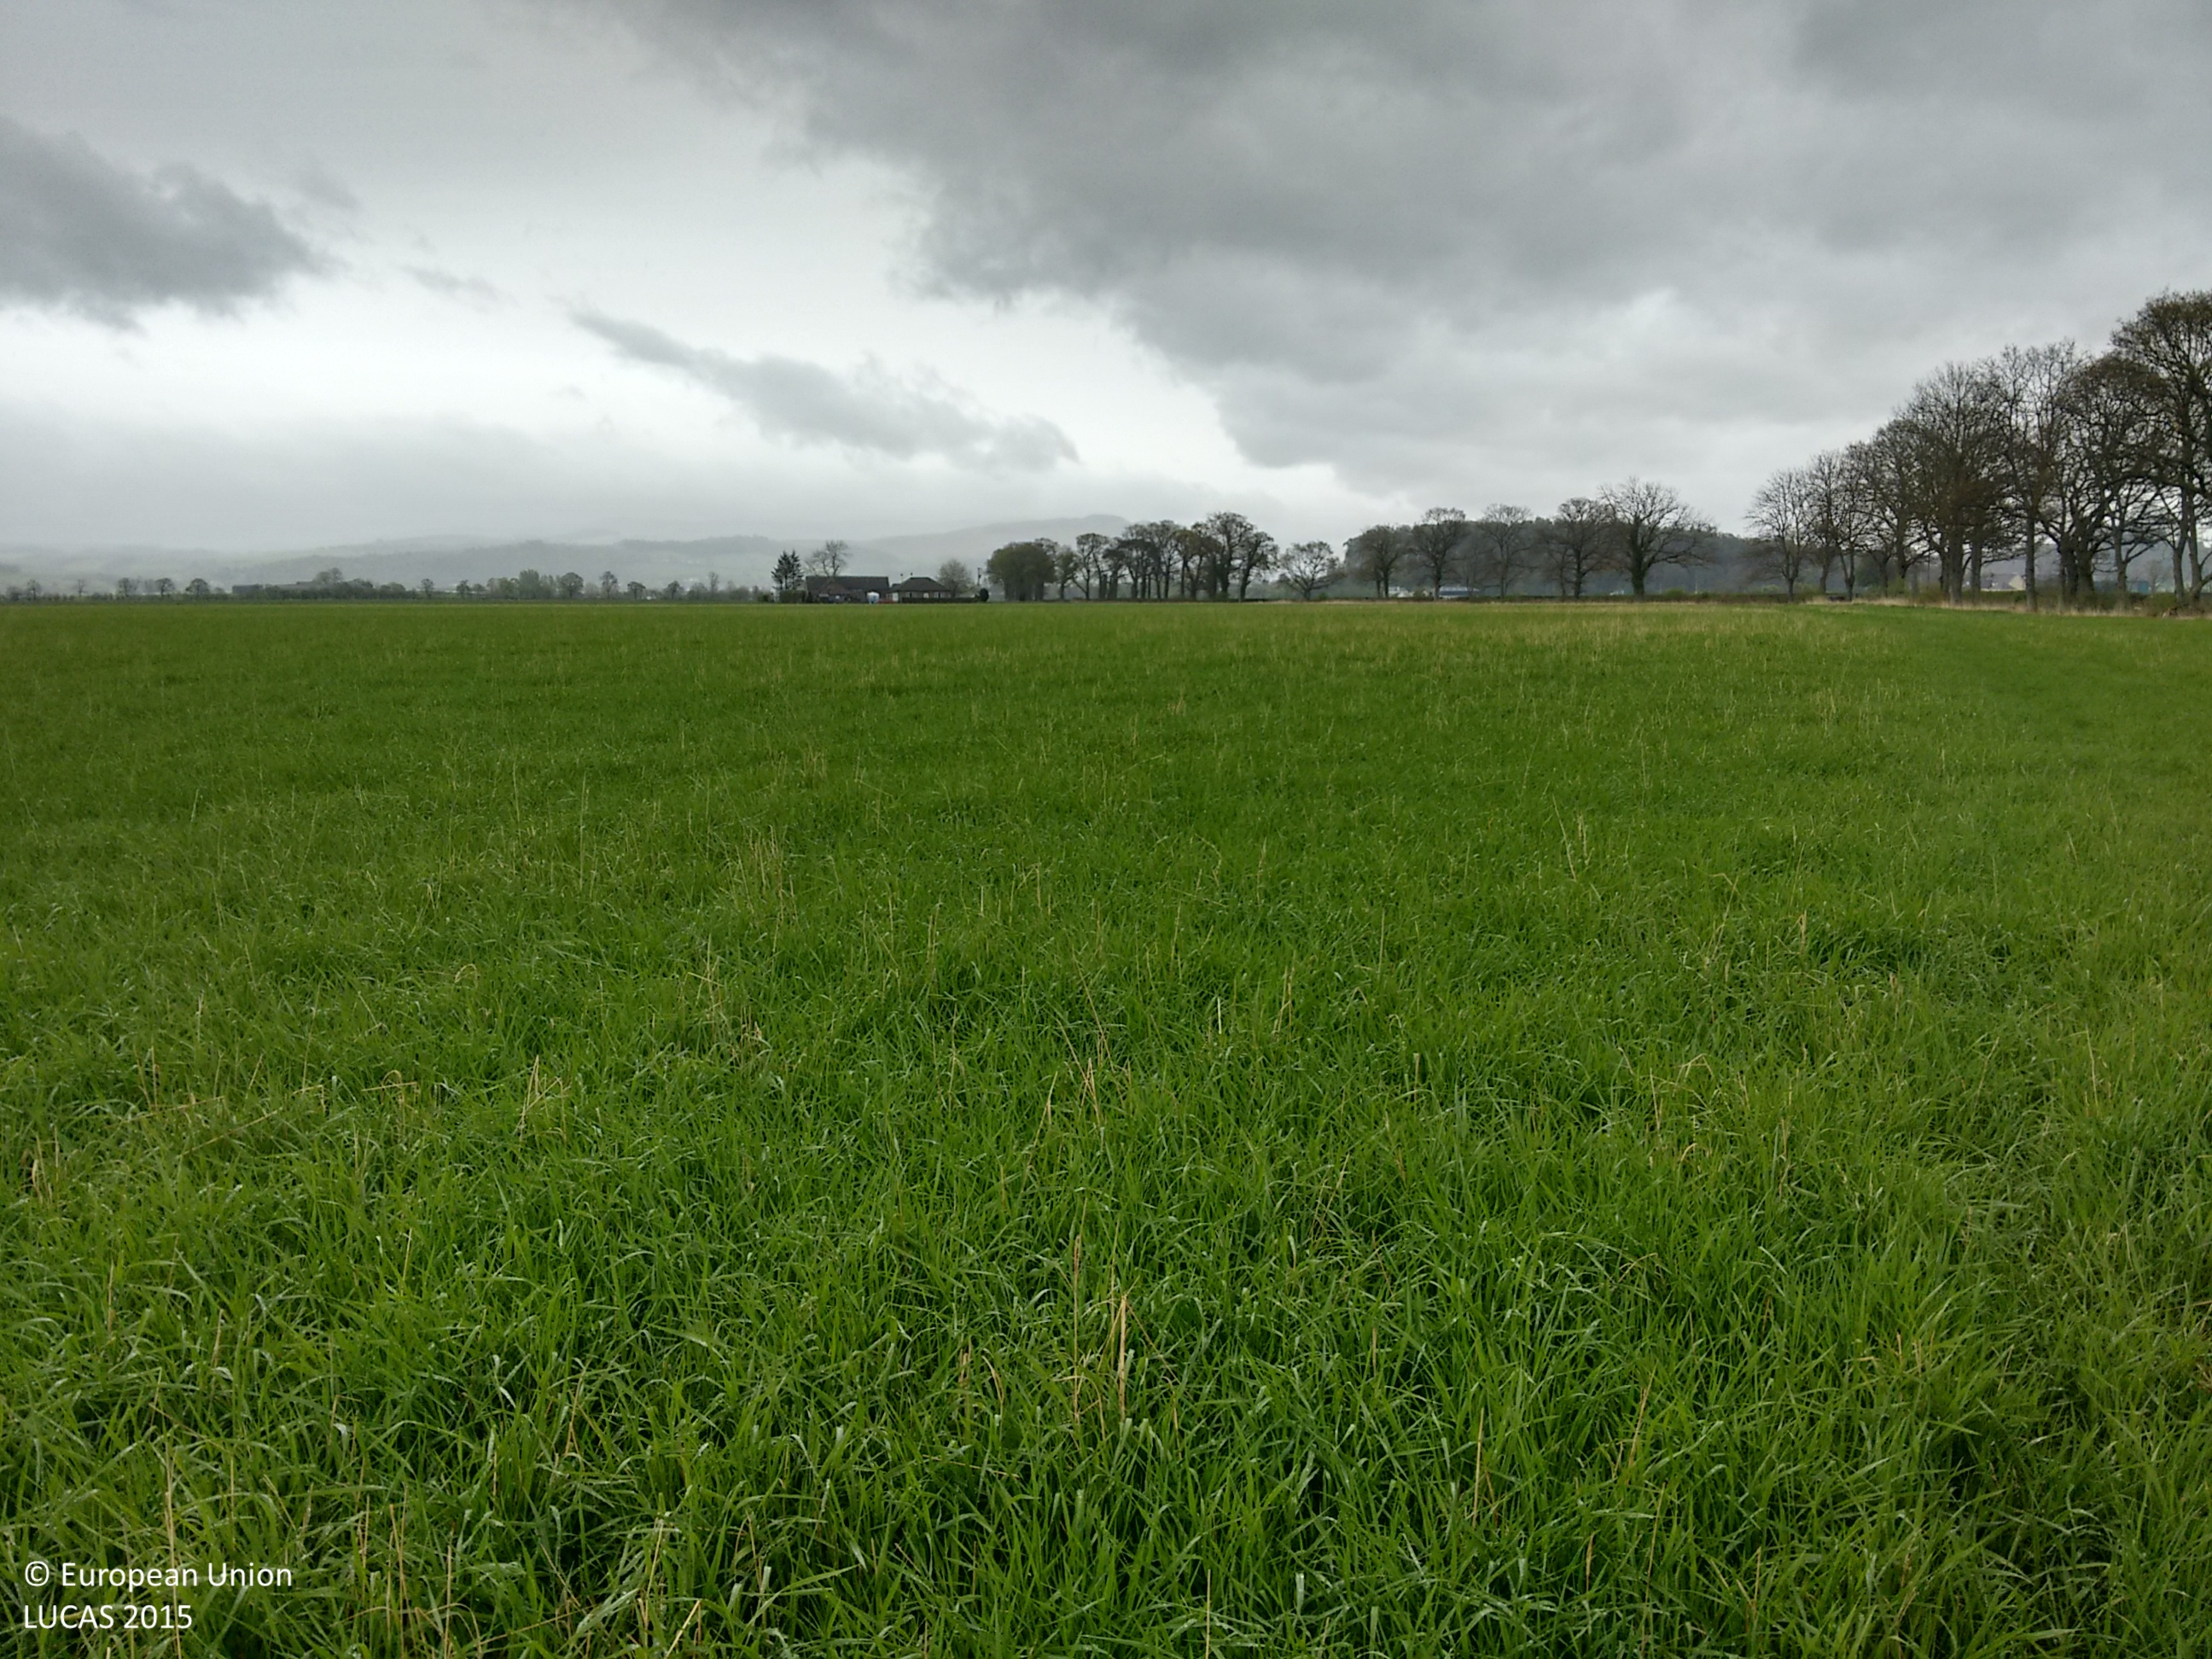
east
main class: Cropland
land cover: Mixed cereals for fodder
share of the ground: > 75 %
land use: Agriculture (excluding fallow land and kitchen gardens)
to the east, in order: Mixed cereals for fodder; Abandoned hedges; Fences; Paved roads, cycling and walking lanes; Electric lines; Oats
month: May
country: GB
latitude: 56.1277
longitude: -4.0028
